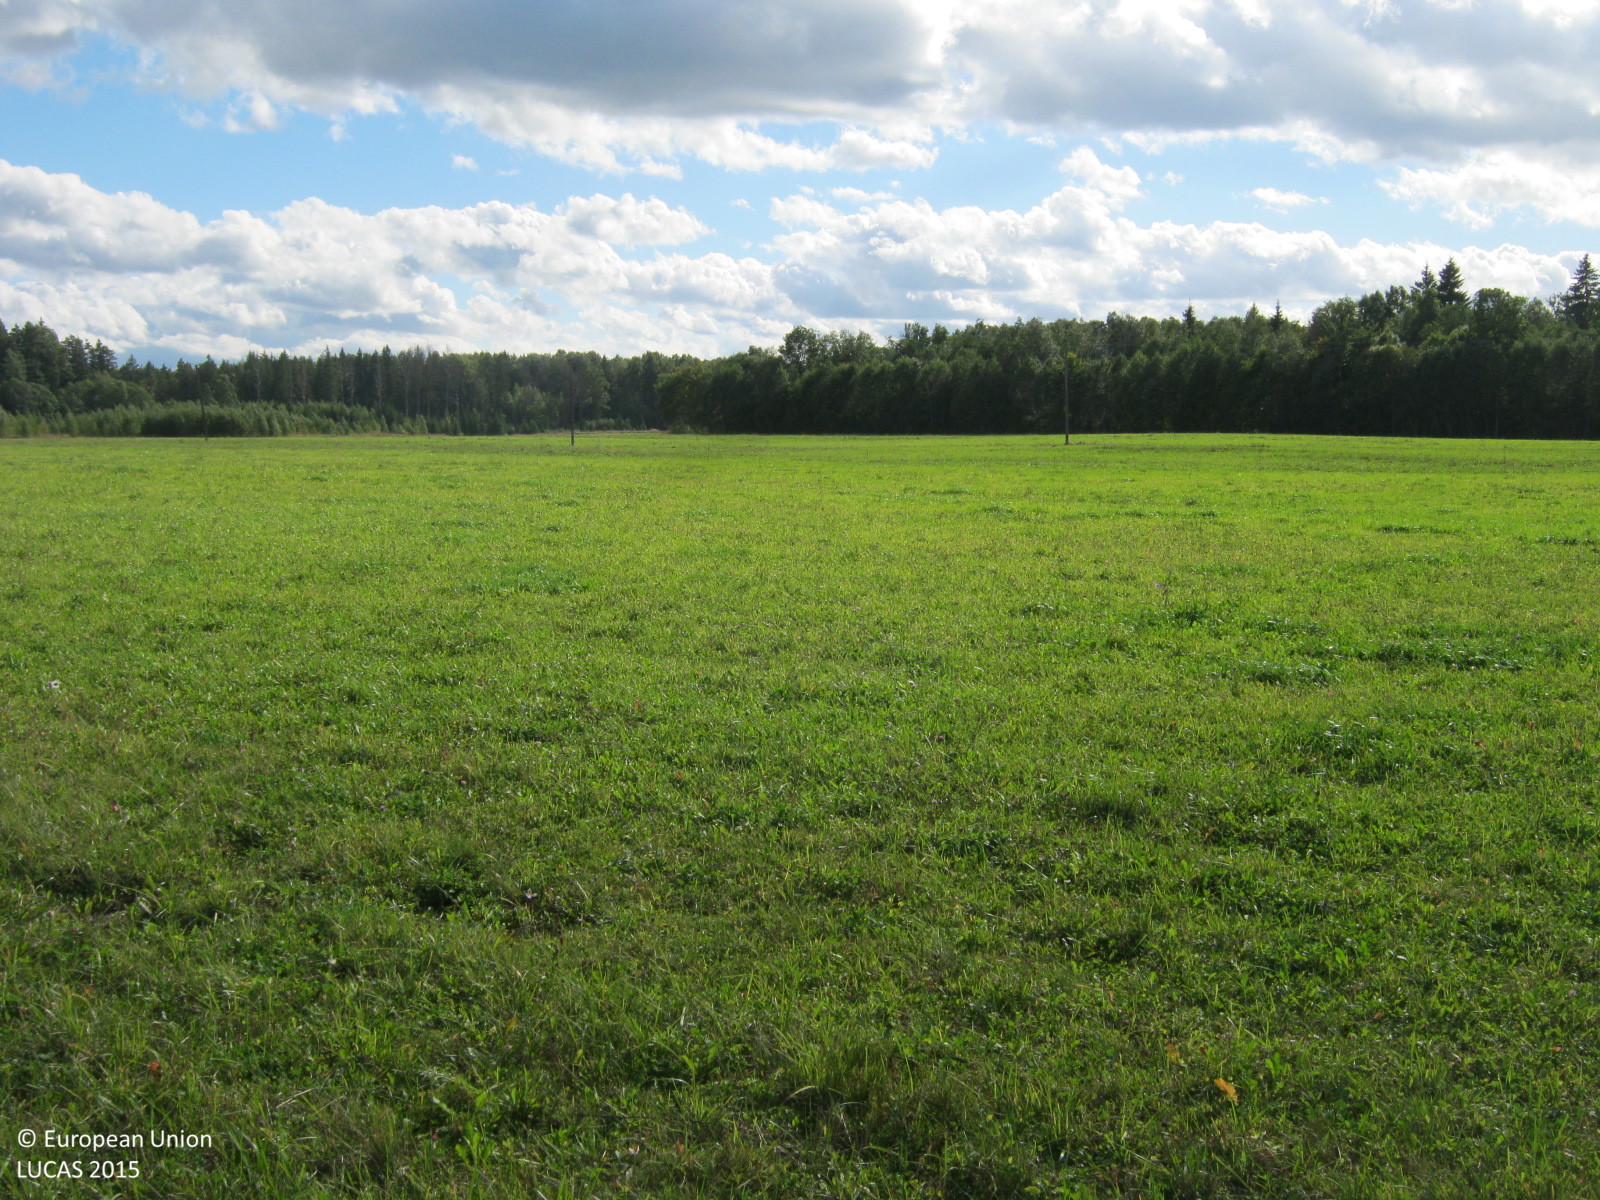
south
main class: Grassland
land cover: Grassland without tree/shrub cover
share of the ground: > 75 %
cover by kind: herbaceous plants 100 %
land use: Agriculture (excluding fallow land and kitchen gardens)
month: September
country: LV
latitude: 57.2338
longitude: 24.5904
